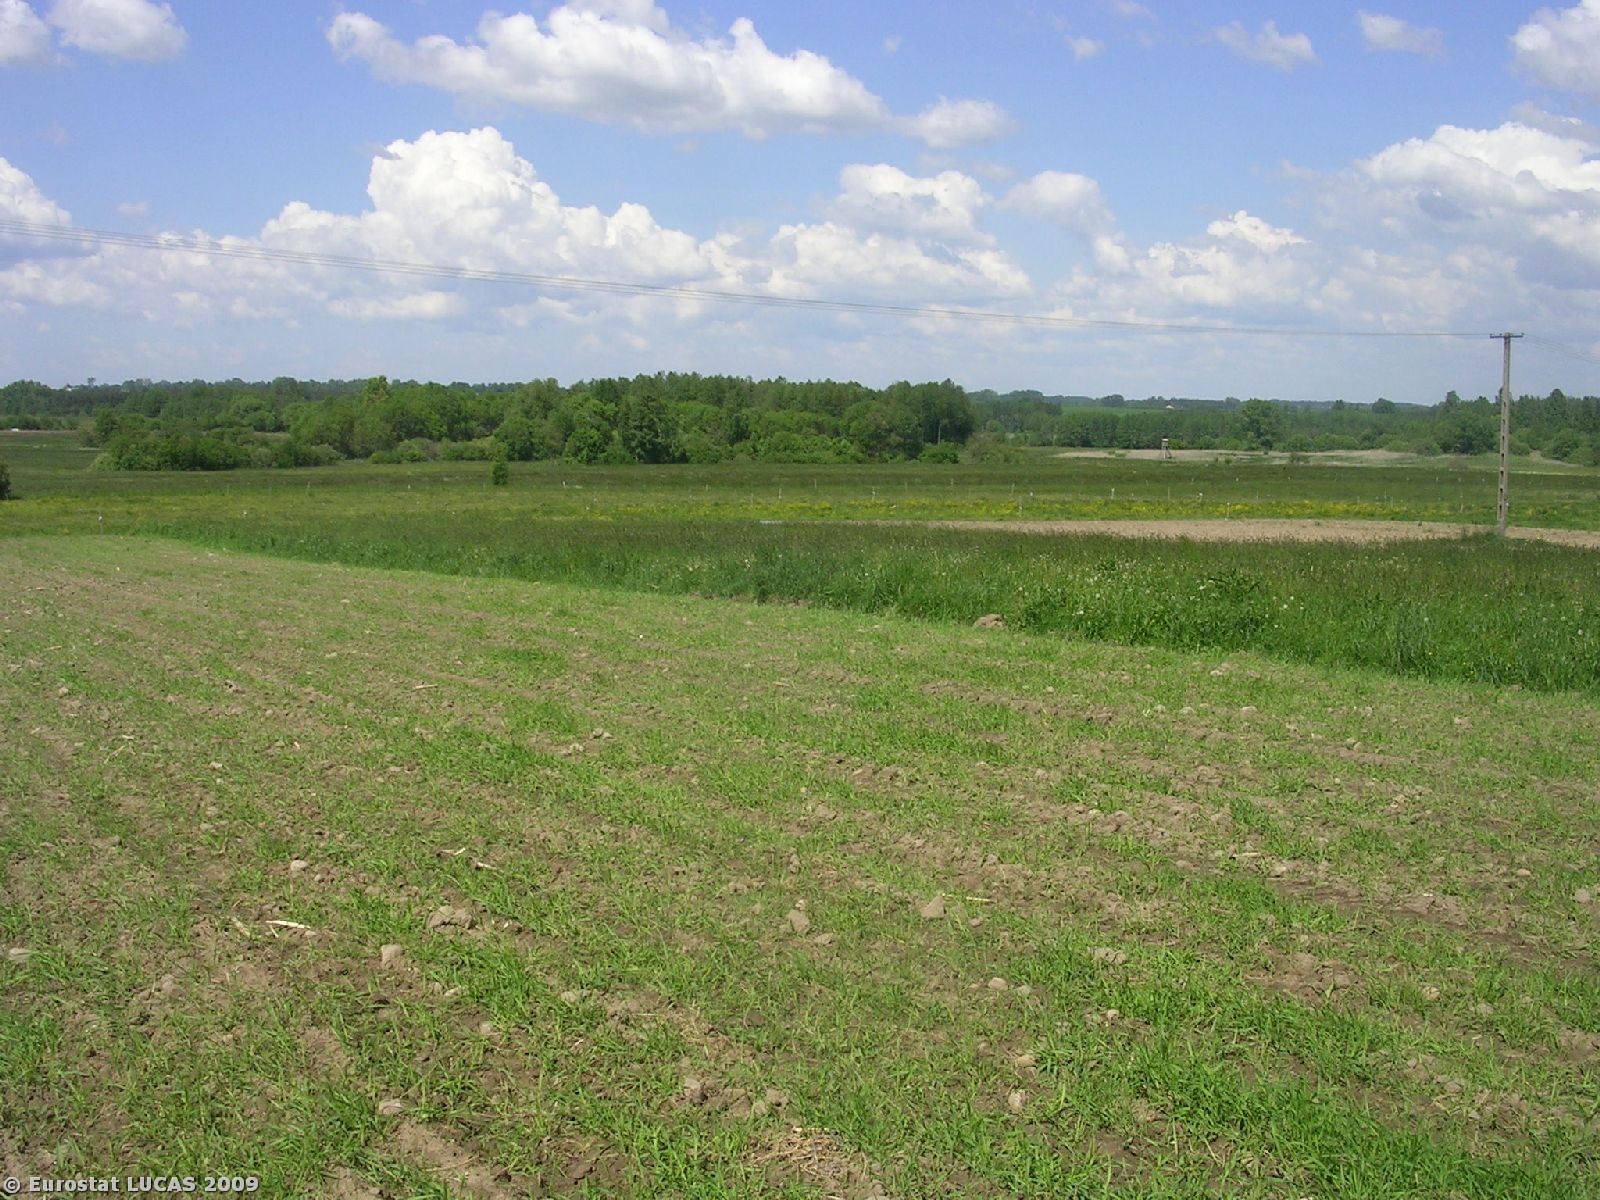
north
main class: Cropland
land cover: Maize
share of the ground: 10 - 25 %
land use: Agriculture (excluding fallow land and kitchen gardens)
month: May
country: PL
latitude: 53.5665
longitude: 23.3836
